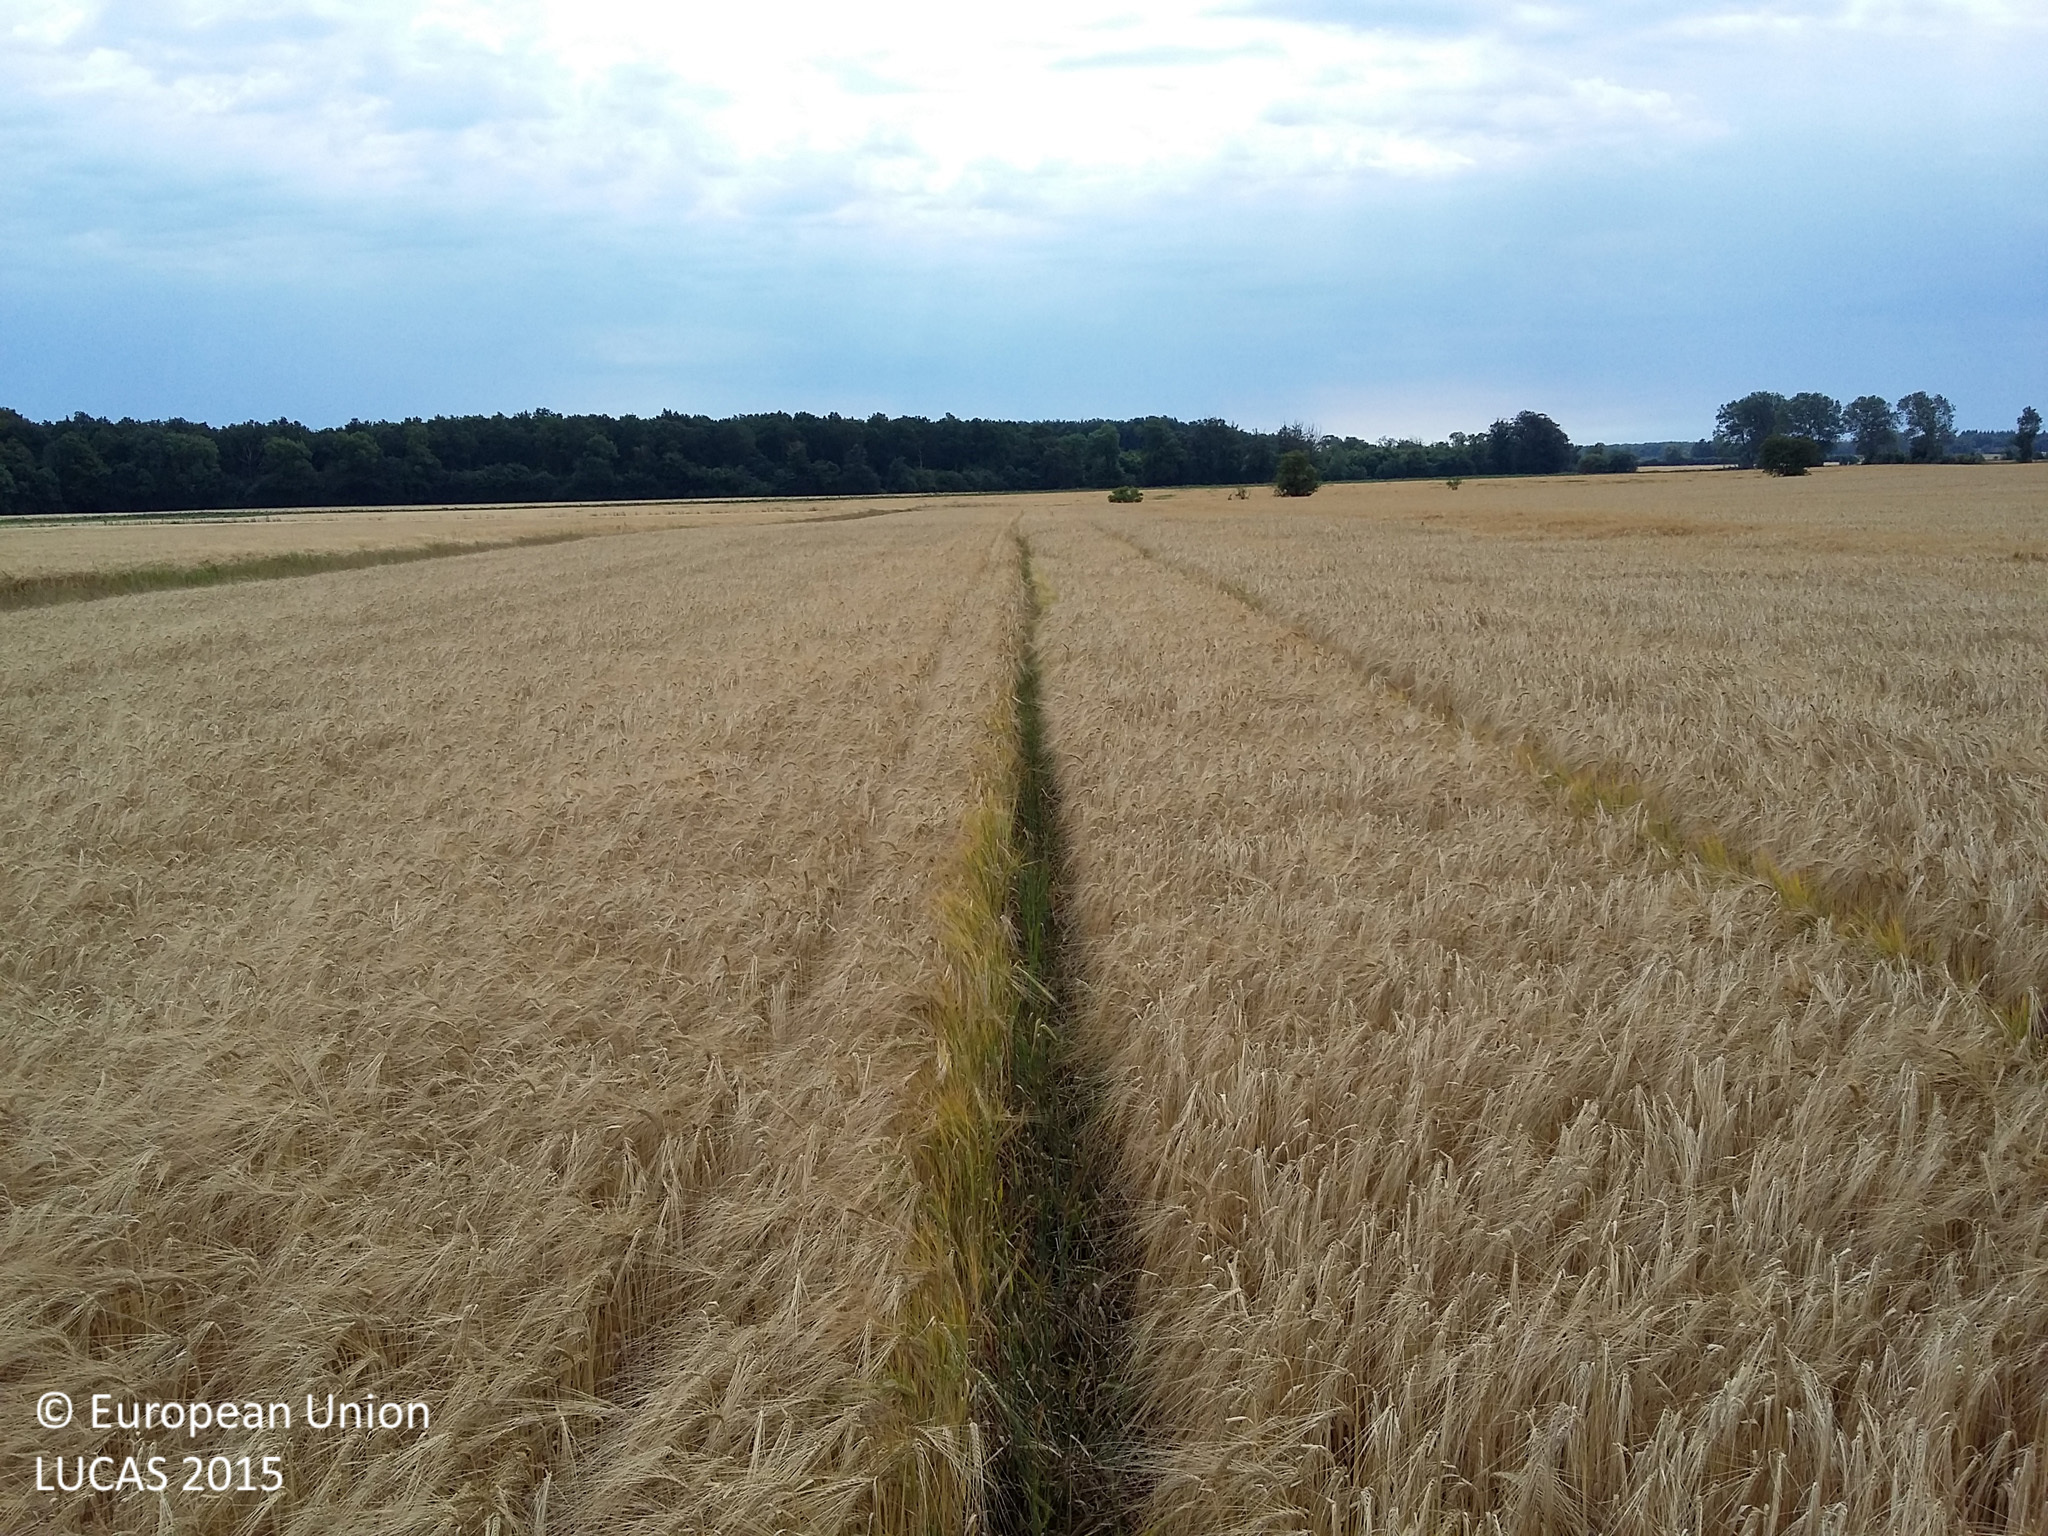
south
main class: Cropland
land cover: Barley
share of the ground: > 75 %
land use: Agriculture (excluding fallow land and kitchen gardens)
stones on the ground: < 10 %
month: August
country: DK
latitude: 55.3430
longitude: 12.1271
